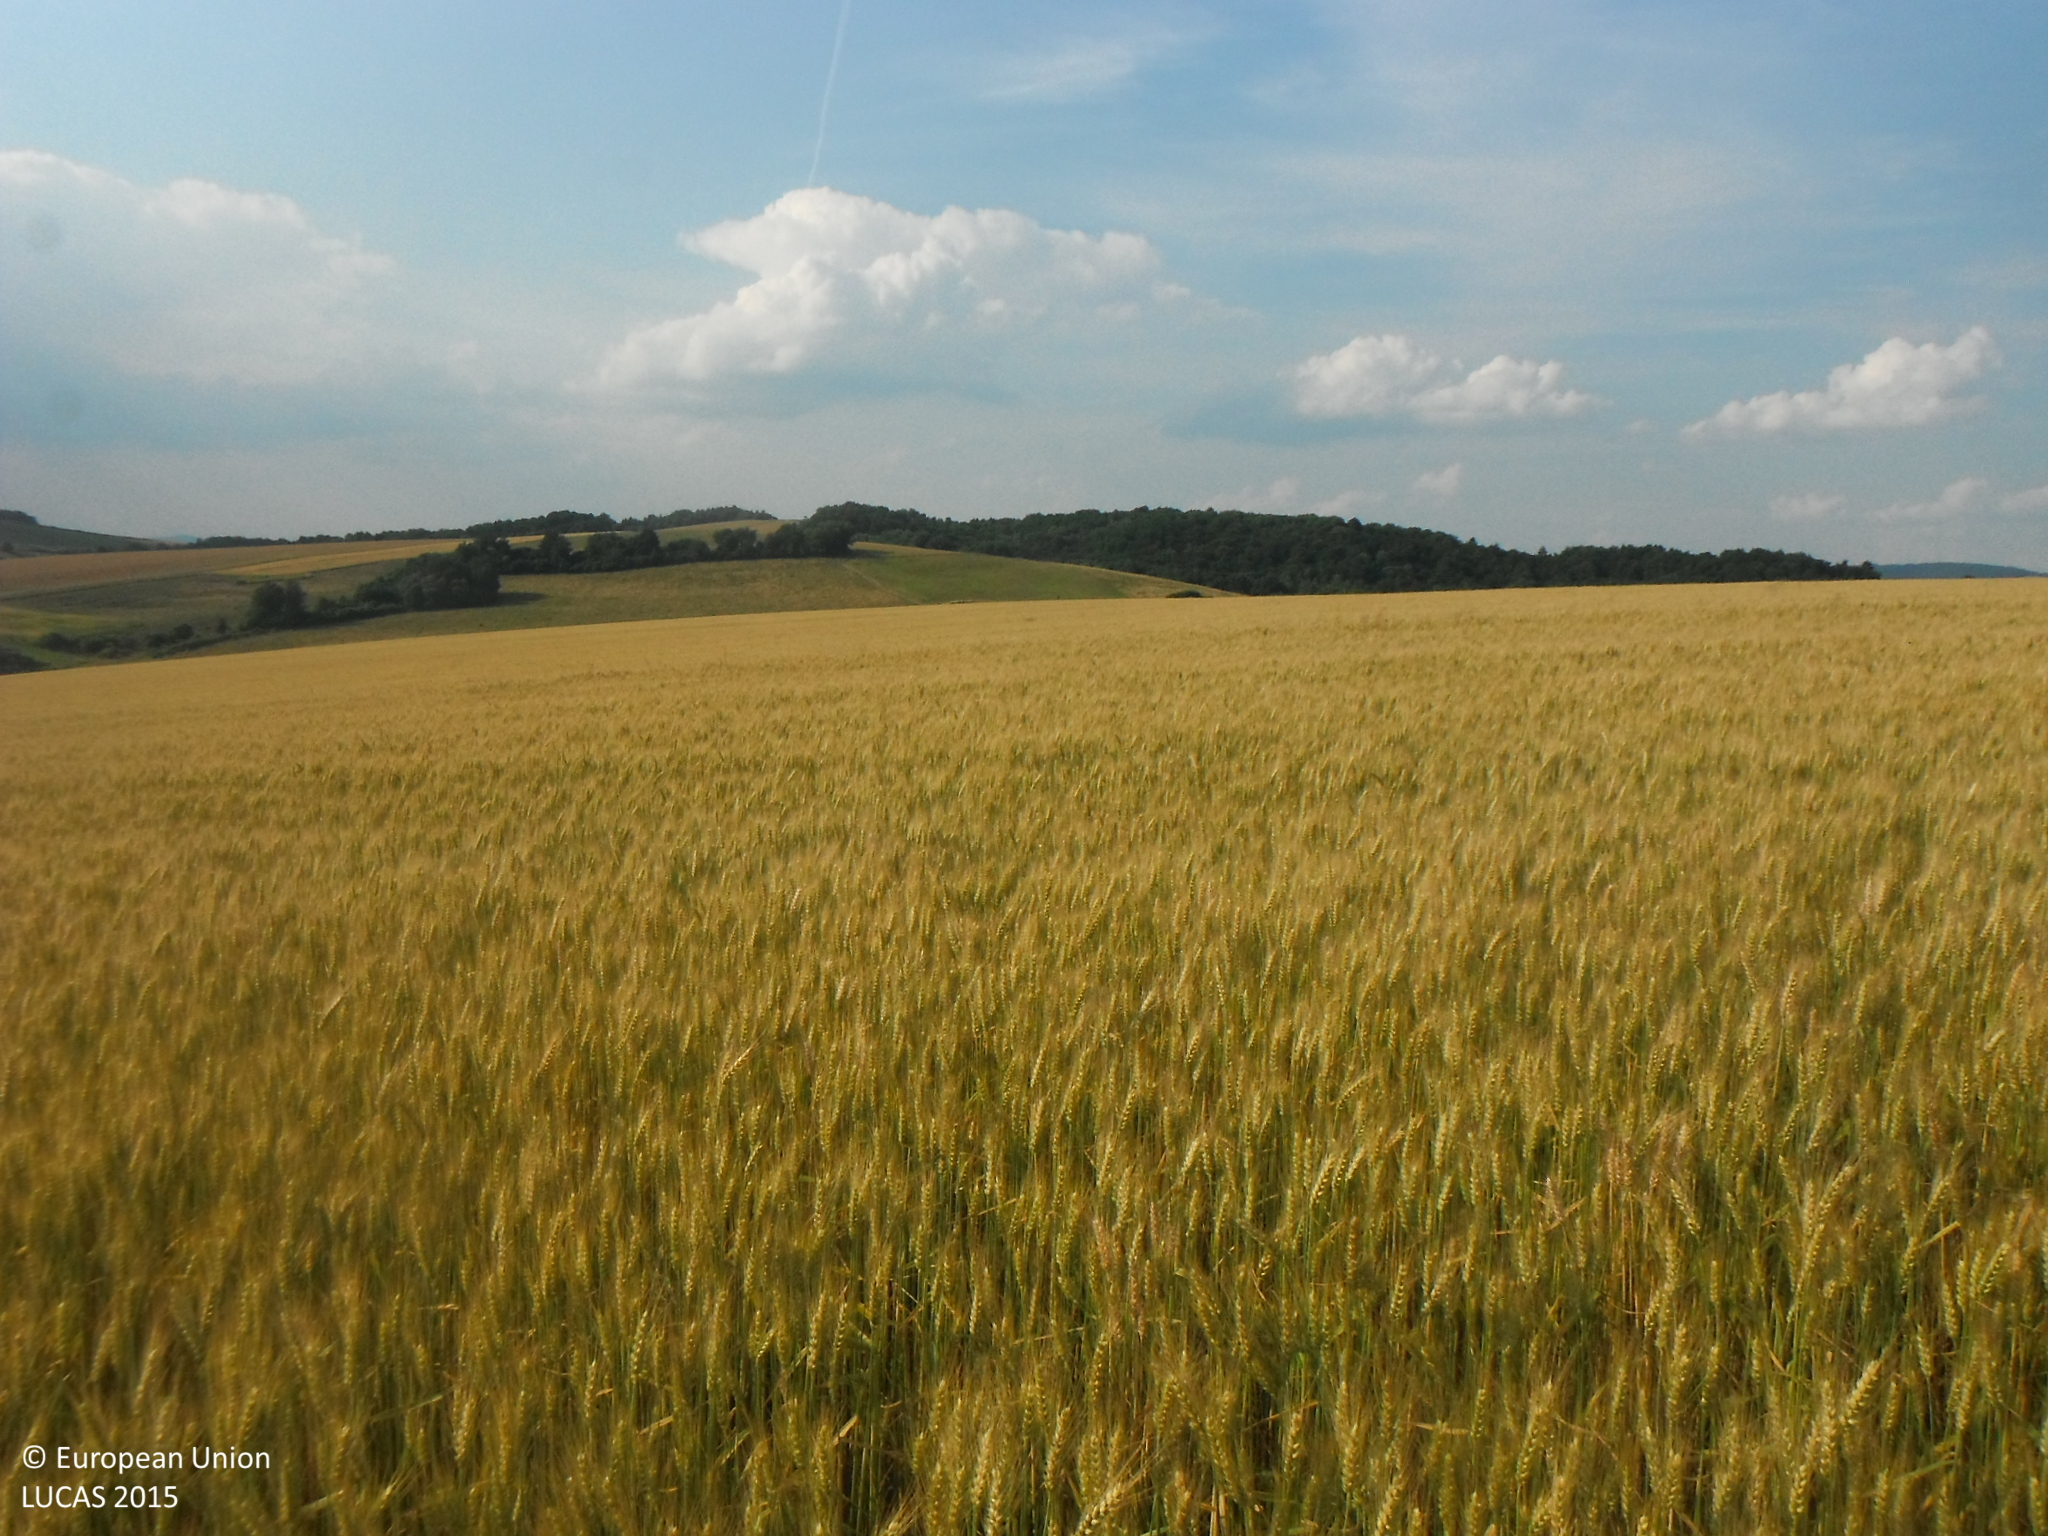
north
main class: Cropland
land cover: Common wheat
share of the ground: > 75 %
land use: Agriculture (excluding fallow land and kitchen gardens)
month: July
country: SK
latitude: 49.0030
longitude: 21.8225
